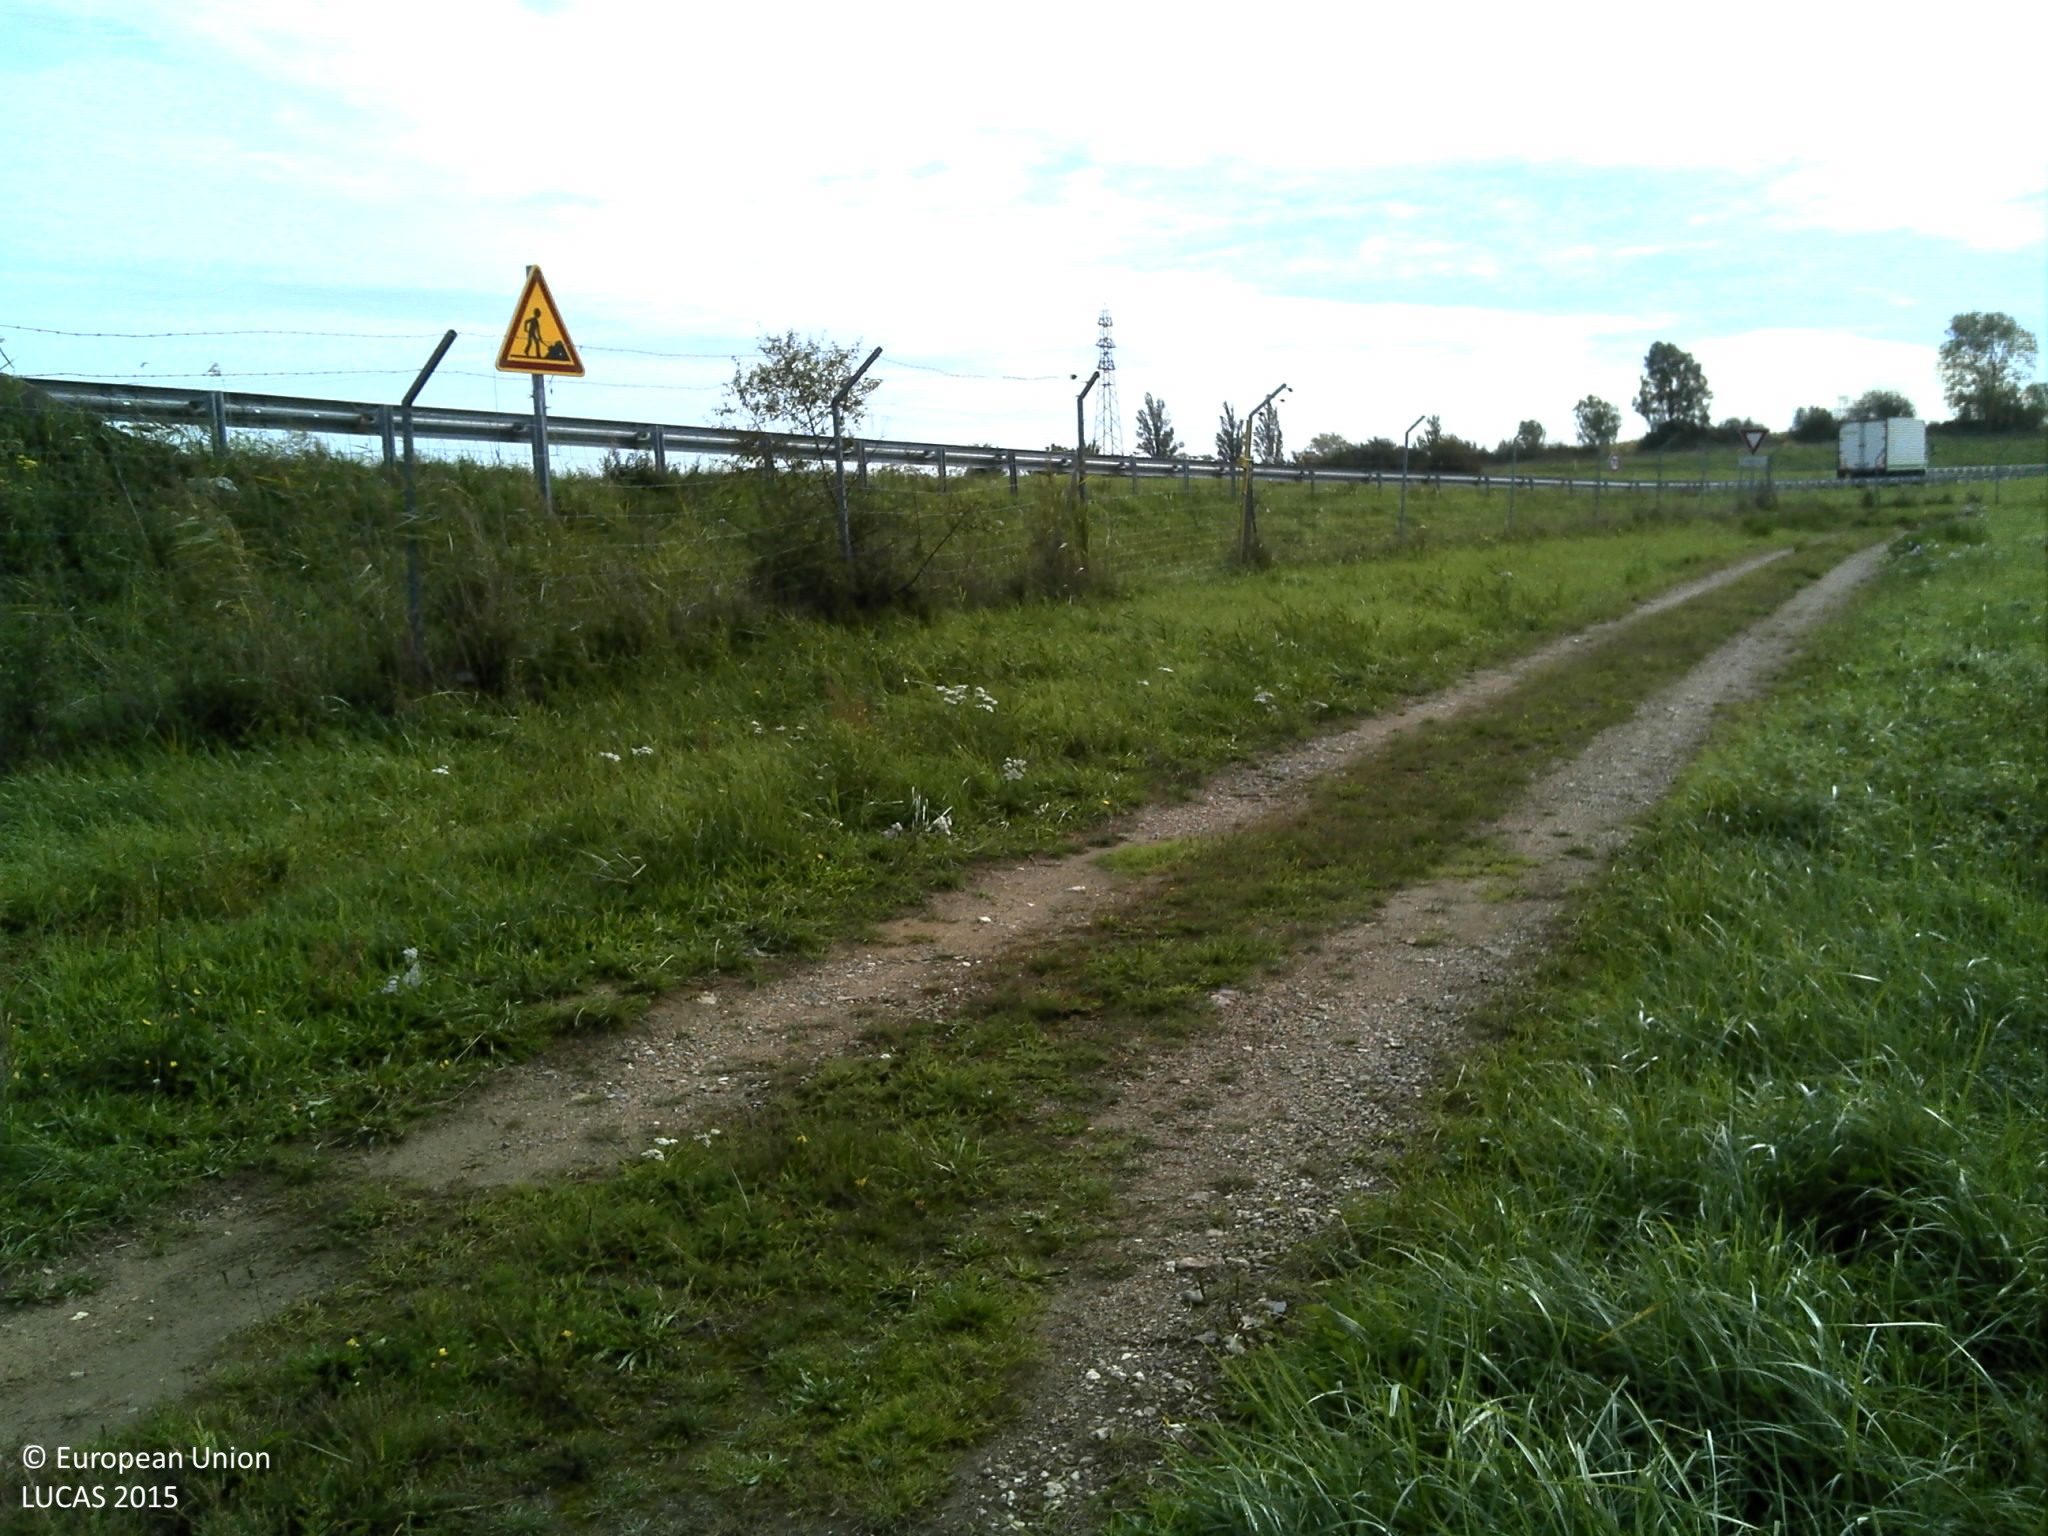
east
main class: Grassland
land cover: Grassland without tree/shrub cover
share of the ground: > 75 %
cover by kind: herbaceous plants 100 %
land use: Semi-natural and natural areas not in use
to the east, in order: Grassland without tree/shrub cover; Tracks; Grassland without tree/shrub cover; Fences; Grassland without tree/shrub cover; Paved roads, cycling and walking lanes; Fences; Grassland without tree/shrub cover; Fences; Electric lines; Paved roads, cycling and walking lanes; Grass margins; Fences; Grassland without tree/shrub cover; Abandoned hedges; Tracks; Grass margins; Maize
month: June
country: FR
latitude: 46.7496
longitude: 4.8307
